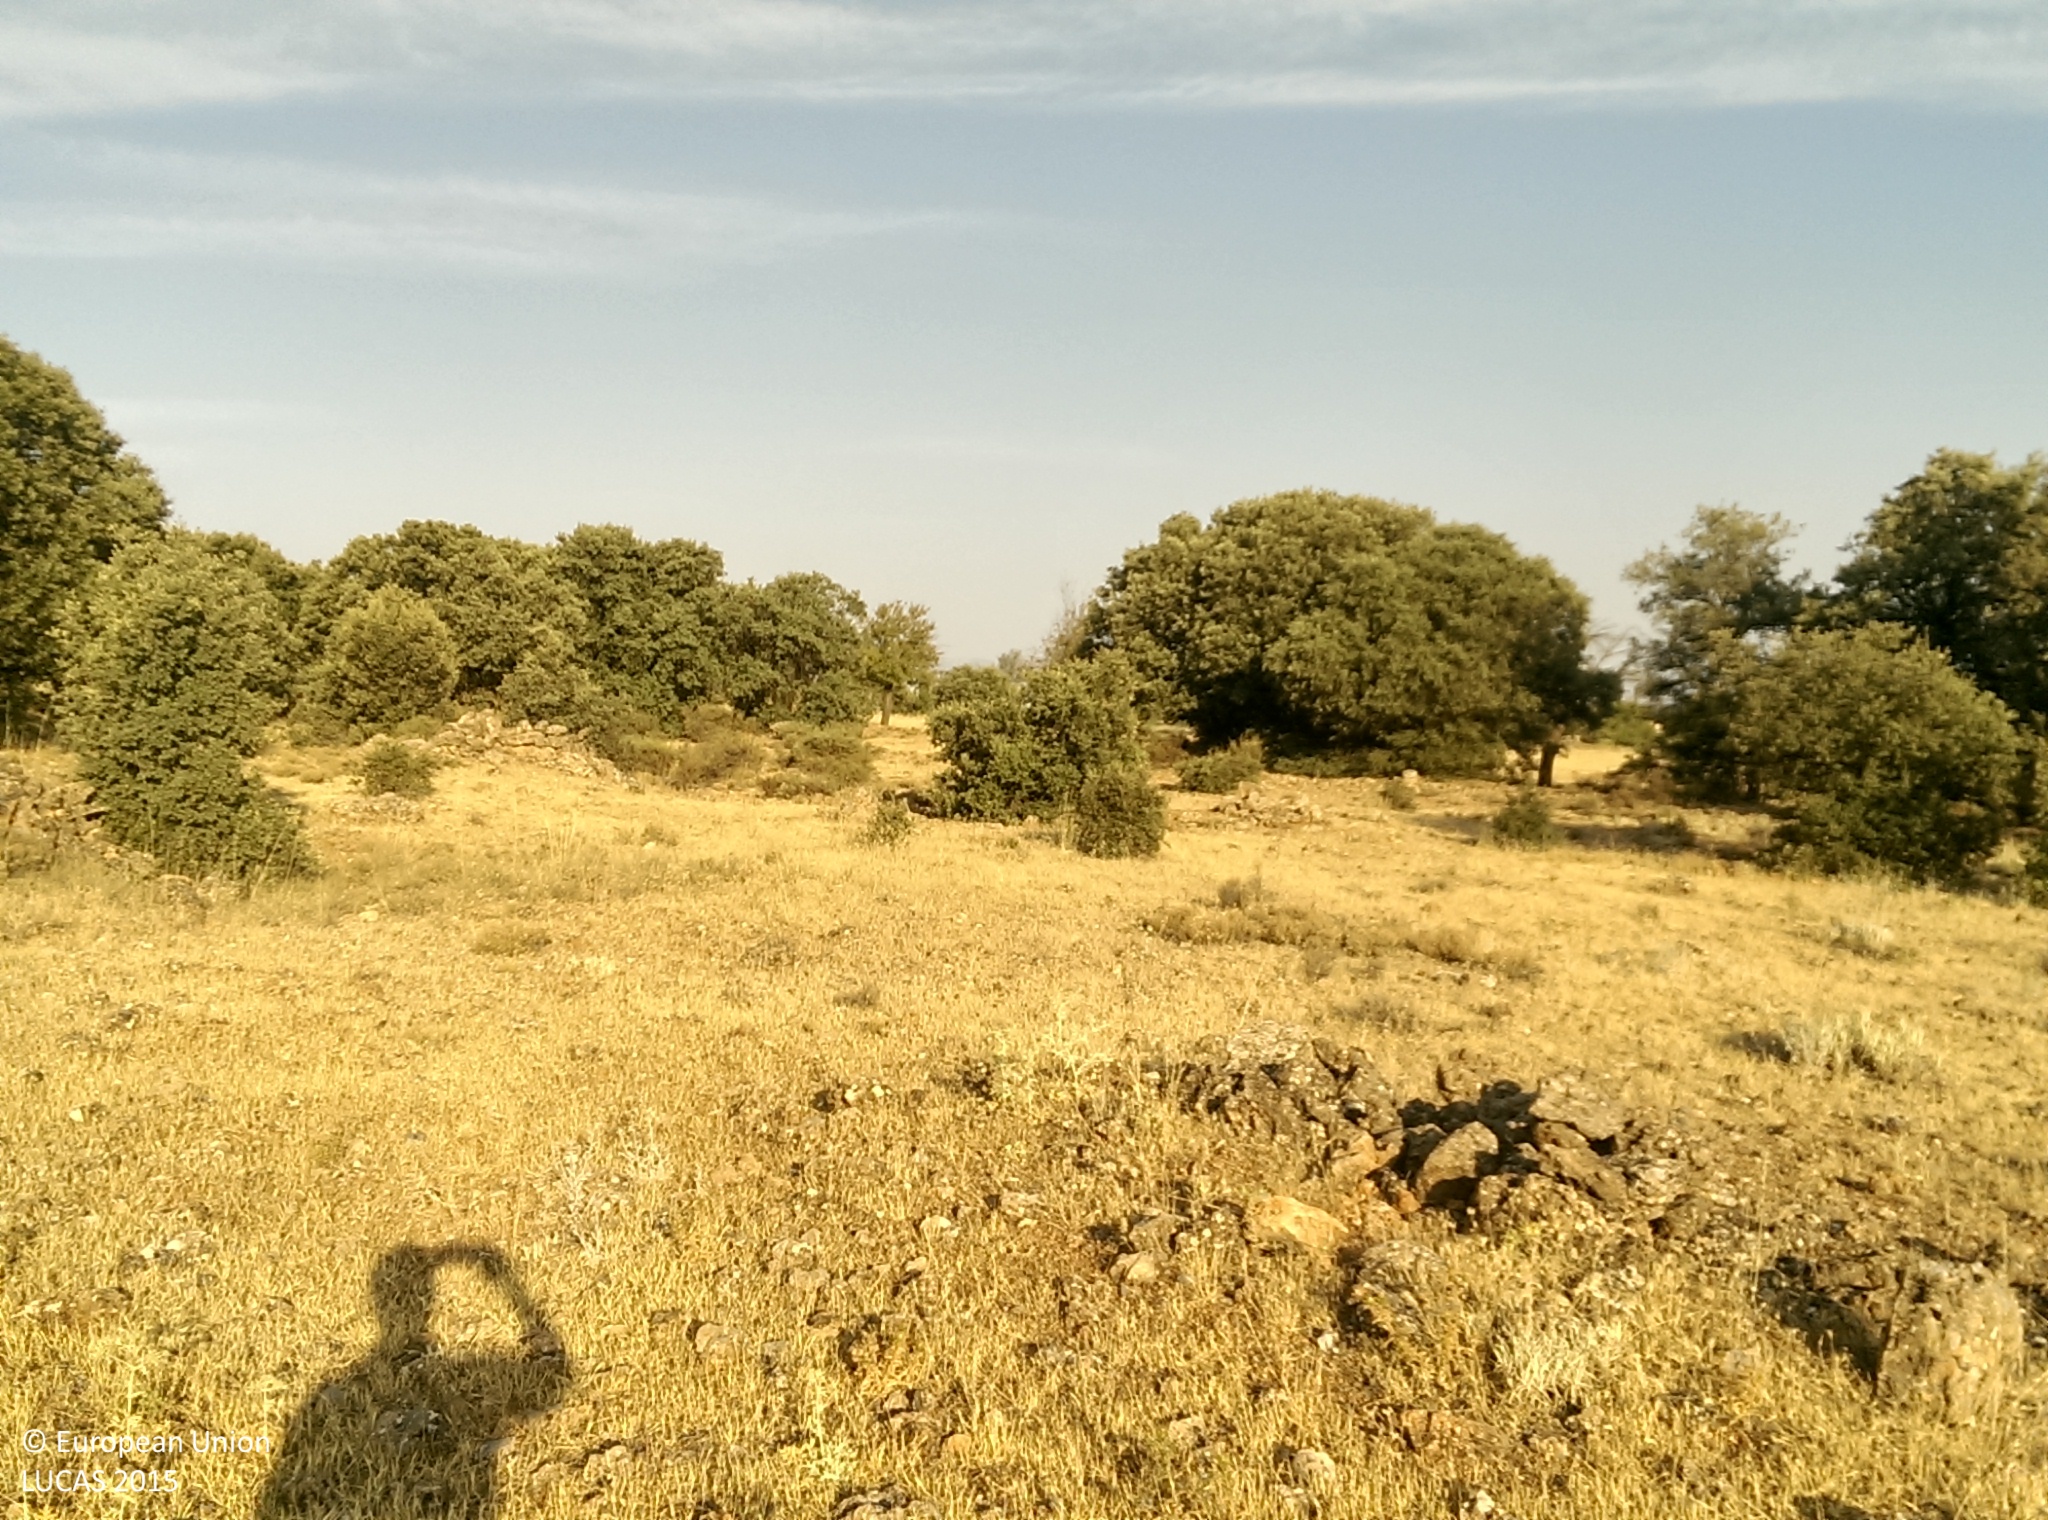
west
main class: Grassland
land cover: Grassland with sparse tree/shrub cover
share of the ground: > 75 %
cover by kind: herbaceous plants 90 %, broadleaved forest trees 5 %, shrubs 5 %
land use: Semi-natural and natural areas not in use
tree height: > 5 m
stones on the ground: > 50 %
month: July
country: ES
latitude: 37.3910
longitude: -2.9424
